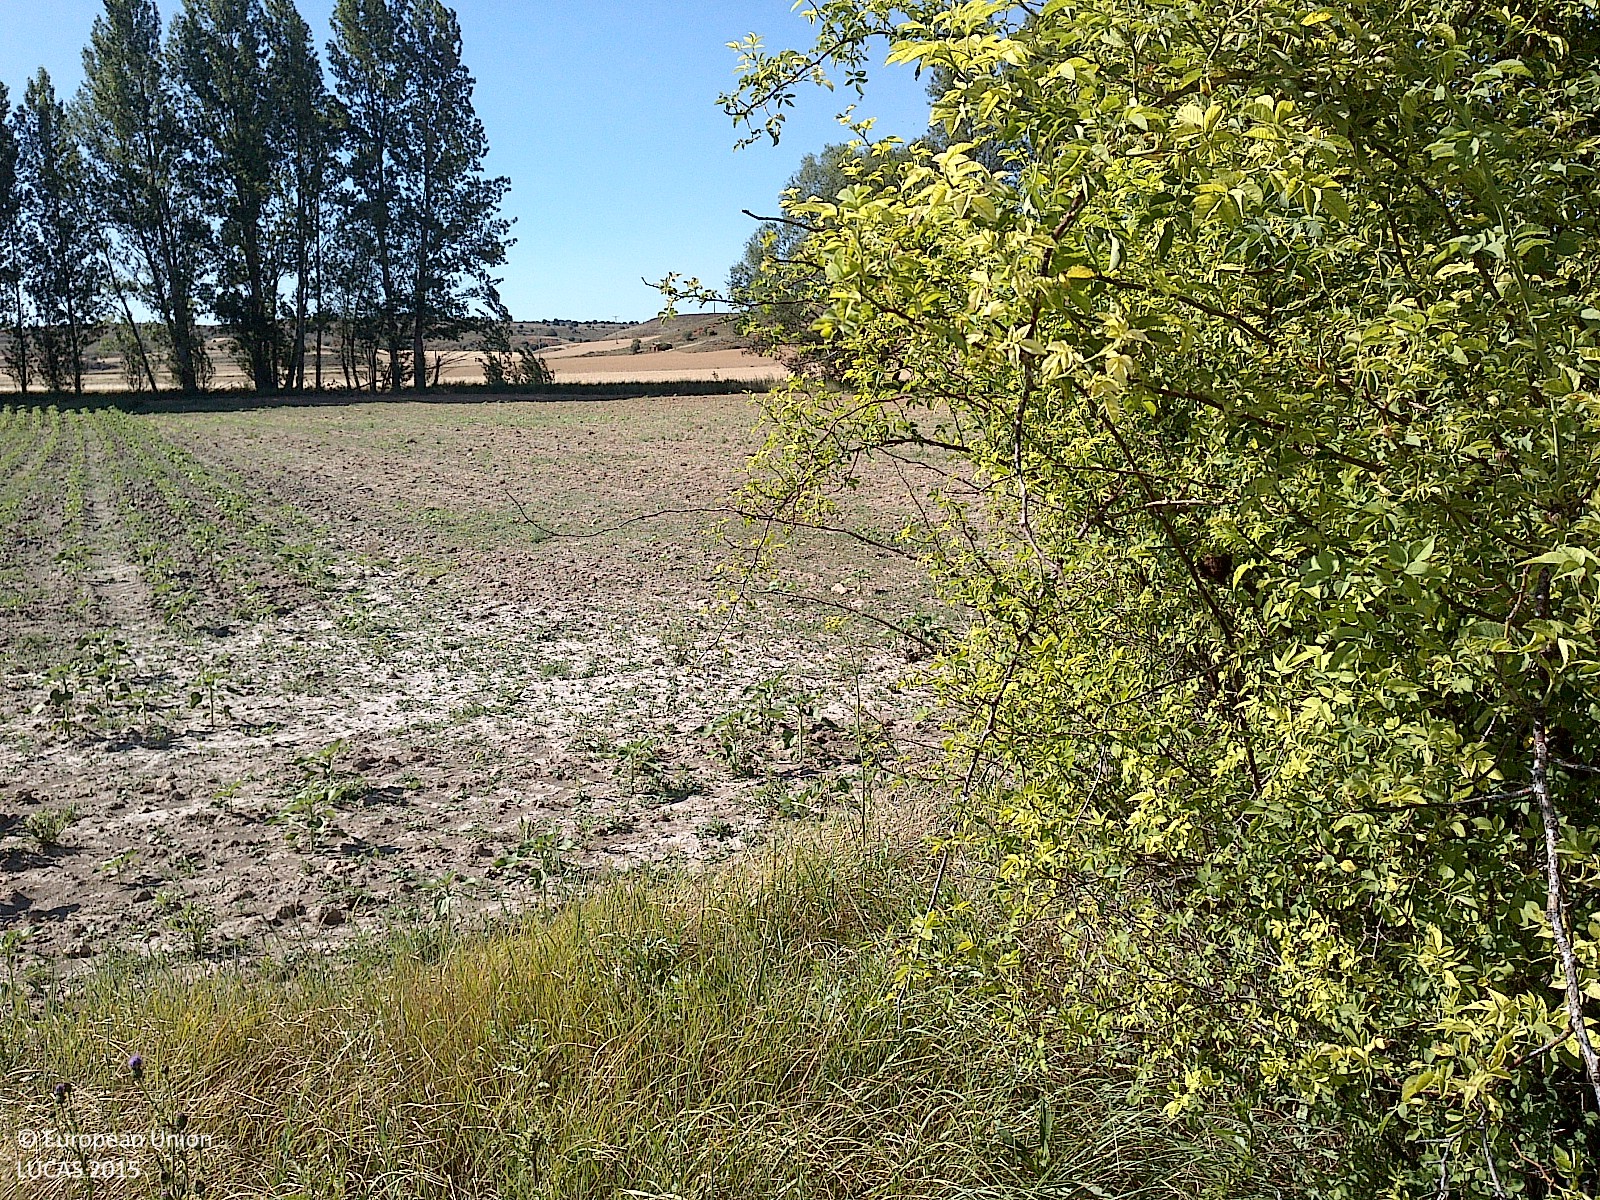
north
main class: Grassland
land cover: Spontaneously vegetated surfaces
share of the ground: > 75 %
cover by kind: herbaceous plants 95 %, shrubs 5 %
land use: Semi-natural and natural areas not in use
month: July
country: ES
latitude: 41.6046
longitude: -2.7705
